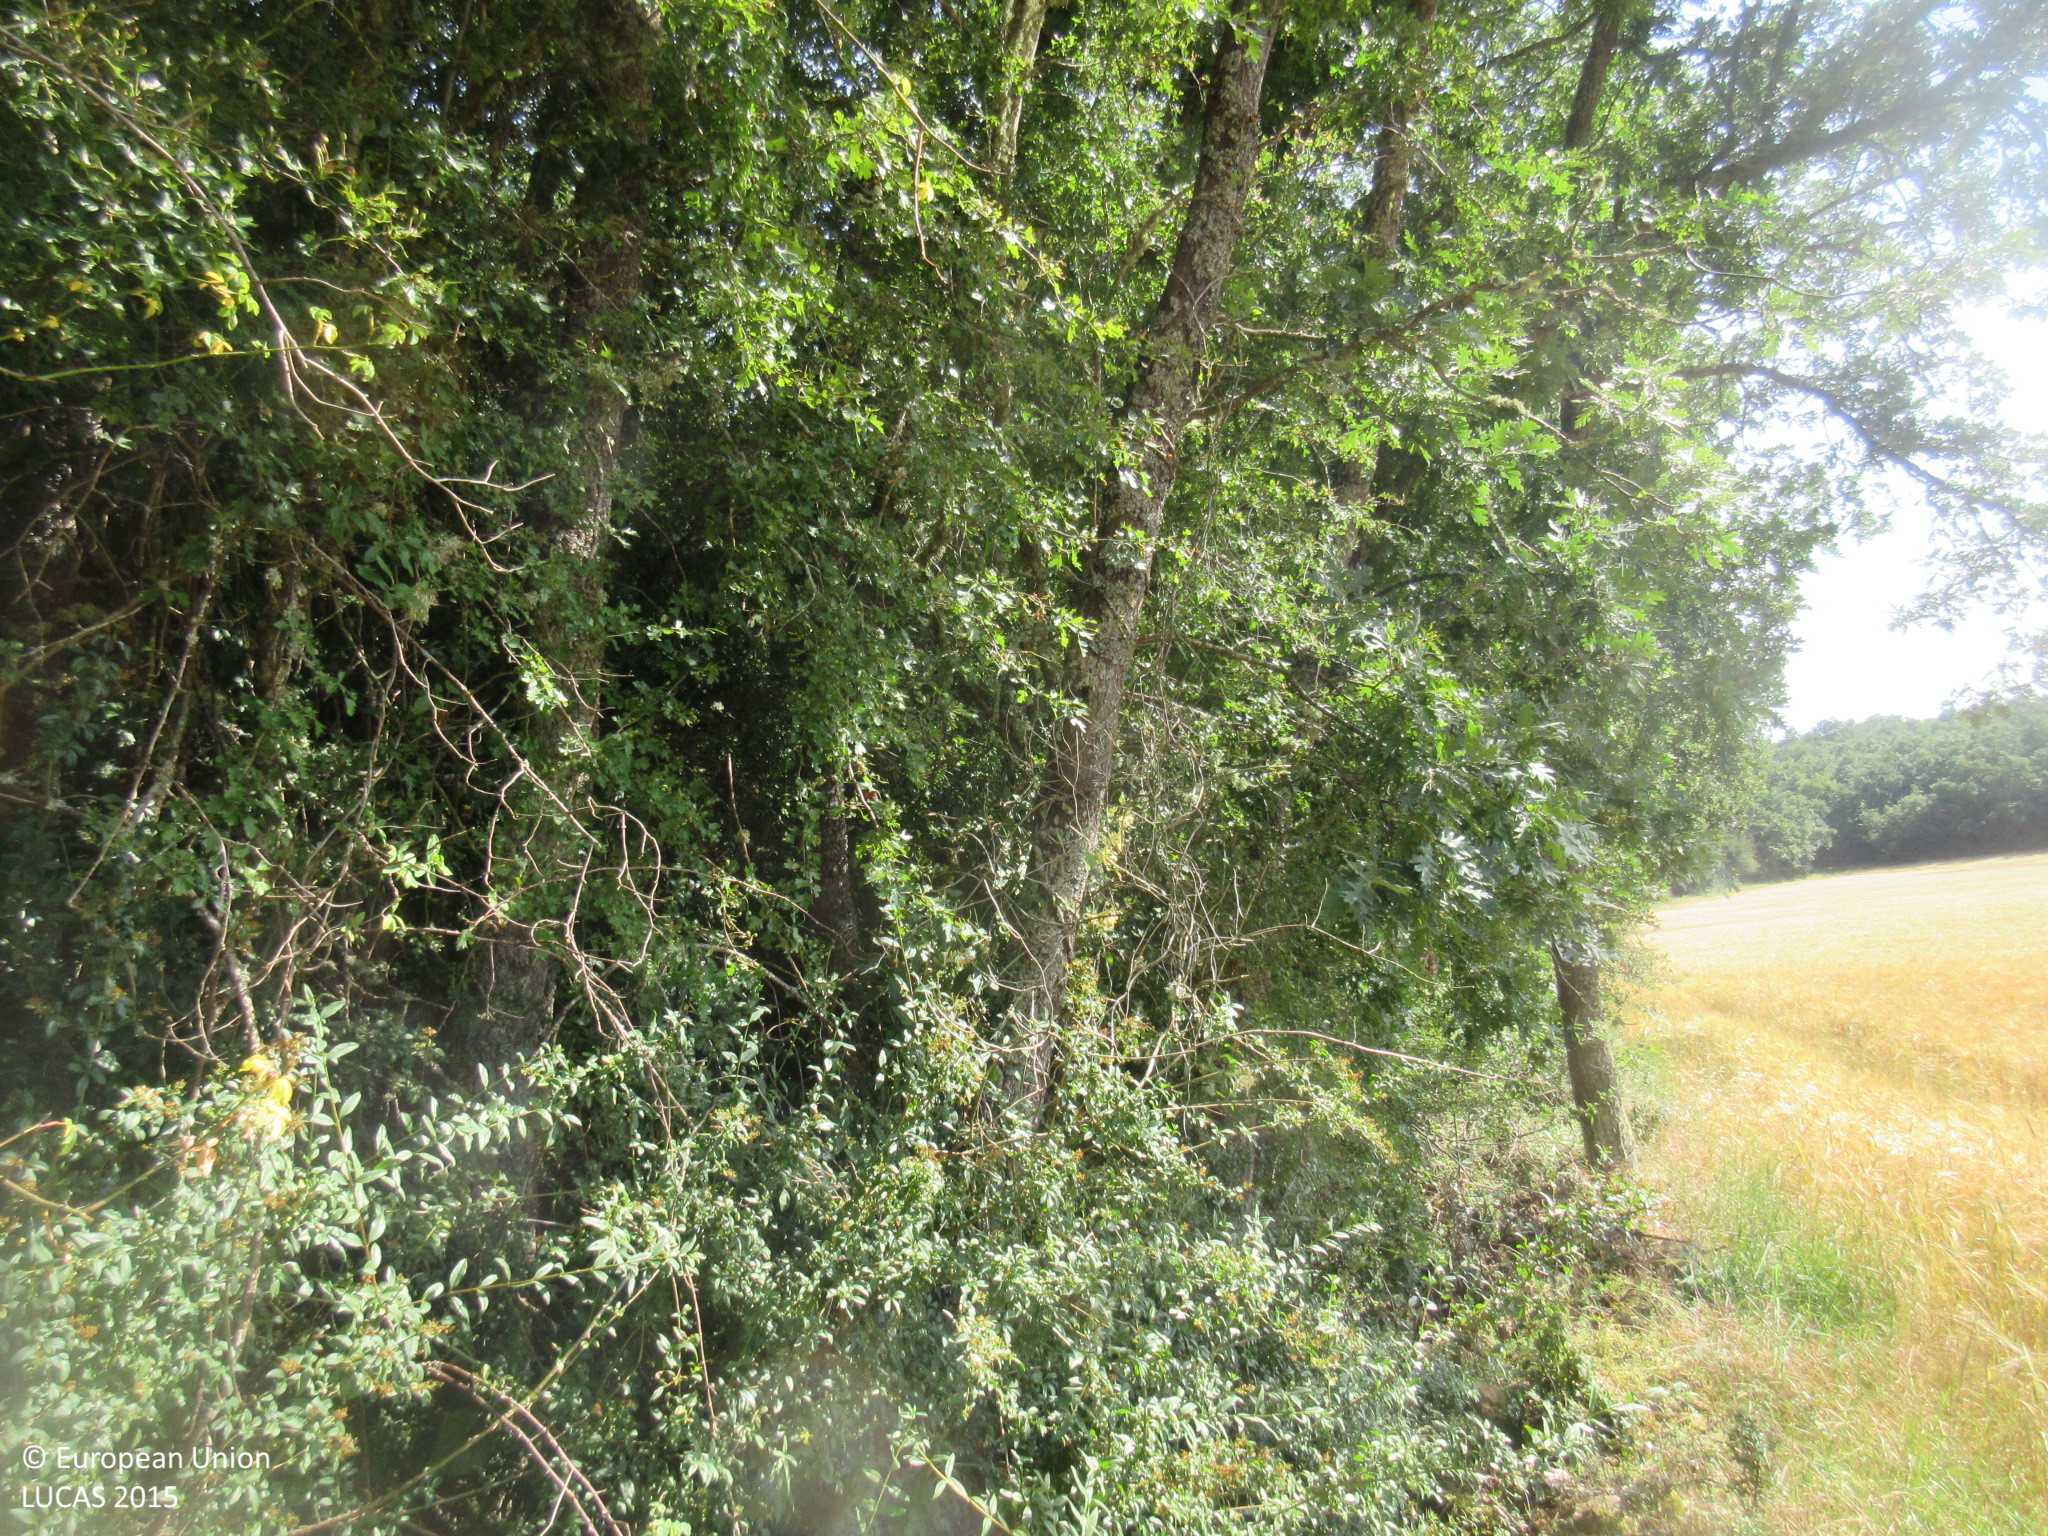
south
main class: Woodland
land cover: Broadleaved woodland
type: acidophilous oak and oak-birch forest
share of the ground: > 75 %
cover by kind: broadleaved forest trees 100 %
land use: Semi-natural and natural areas not in use
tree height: > 5 m
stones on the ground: < 10 %
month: July
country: ES
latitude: 42.9991
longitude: -3.4215
